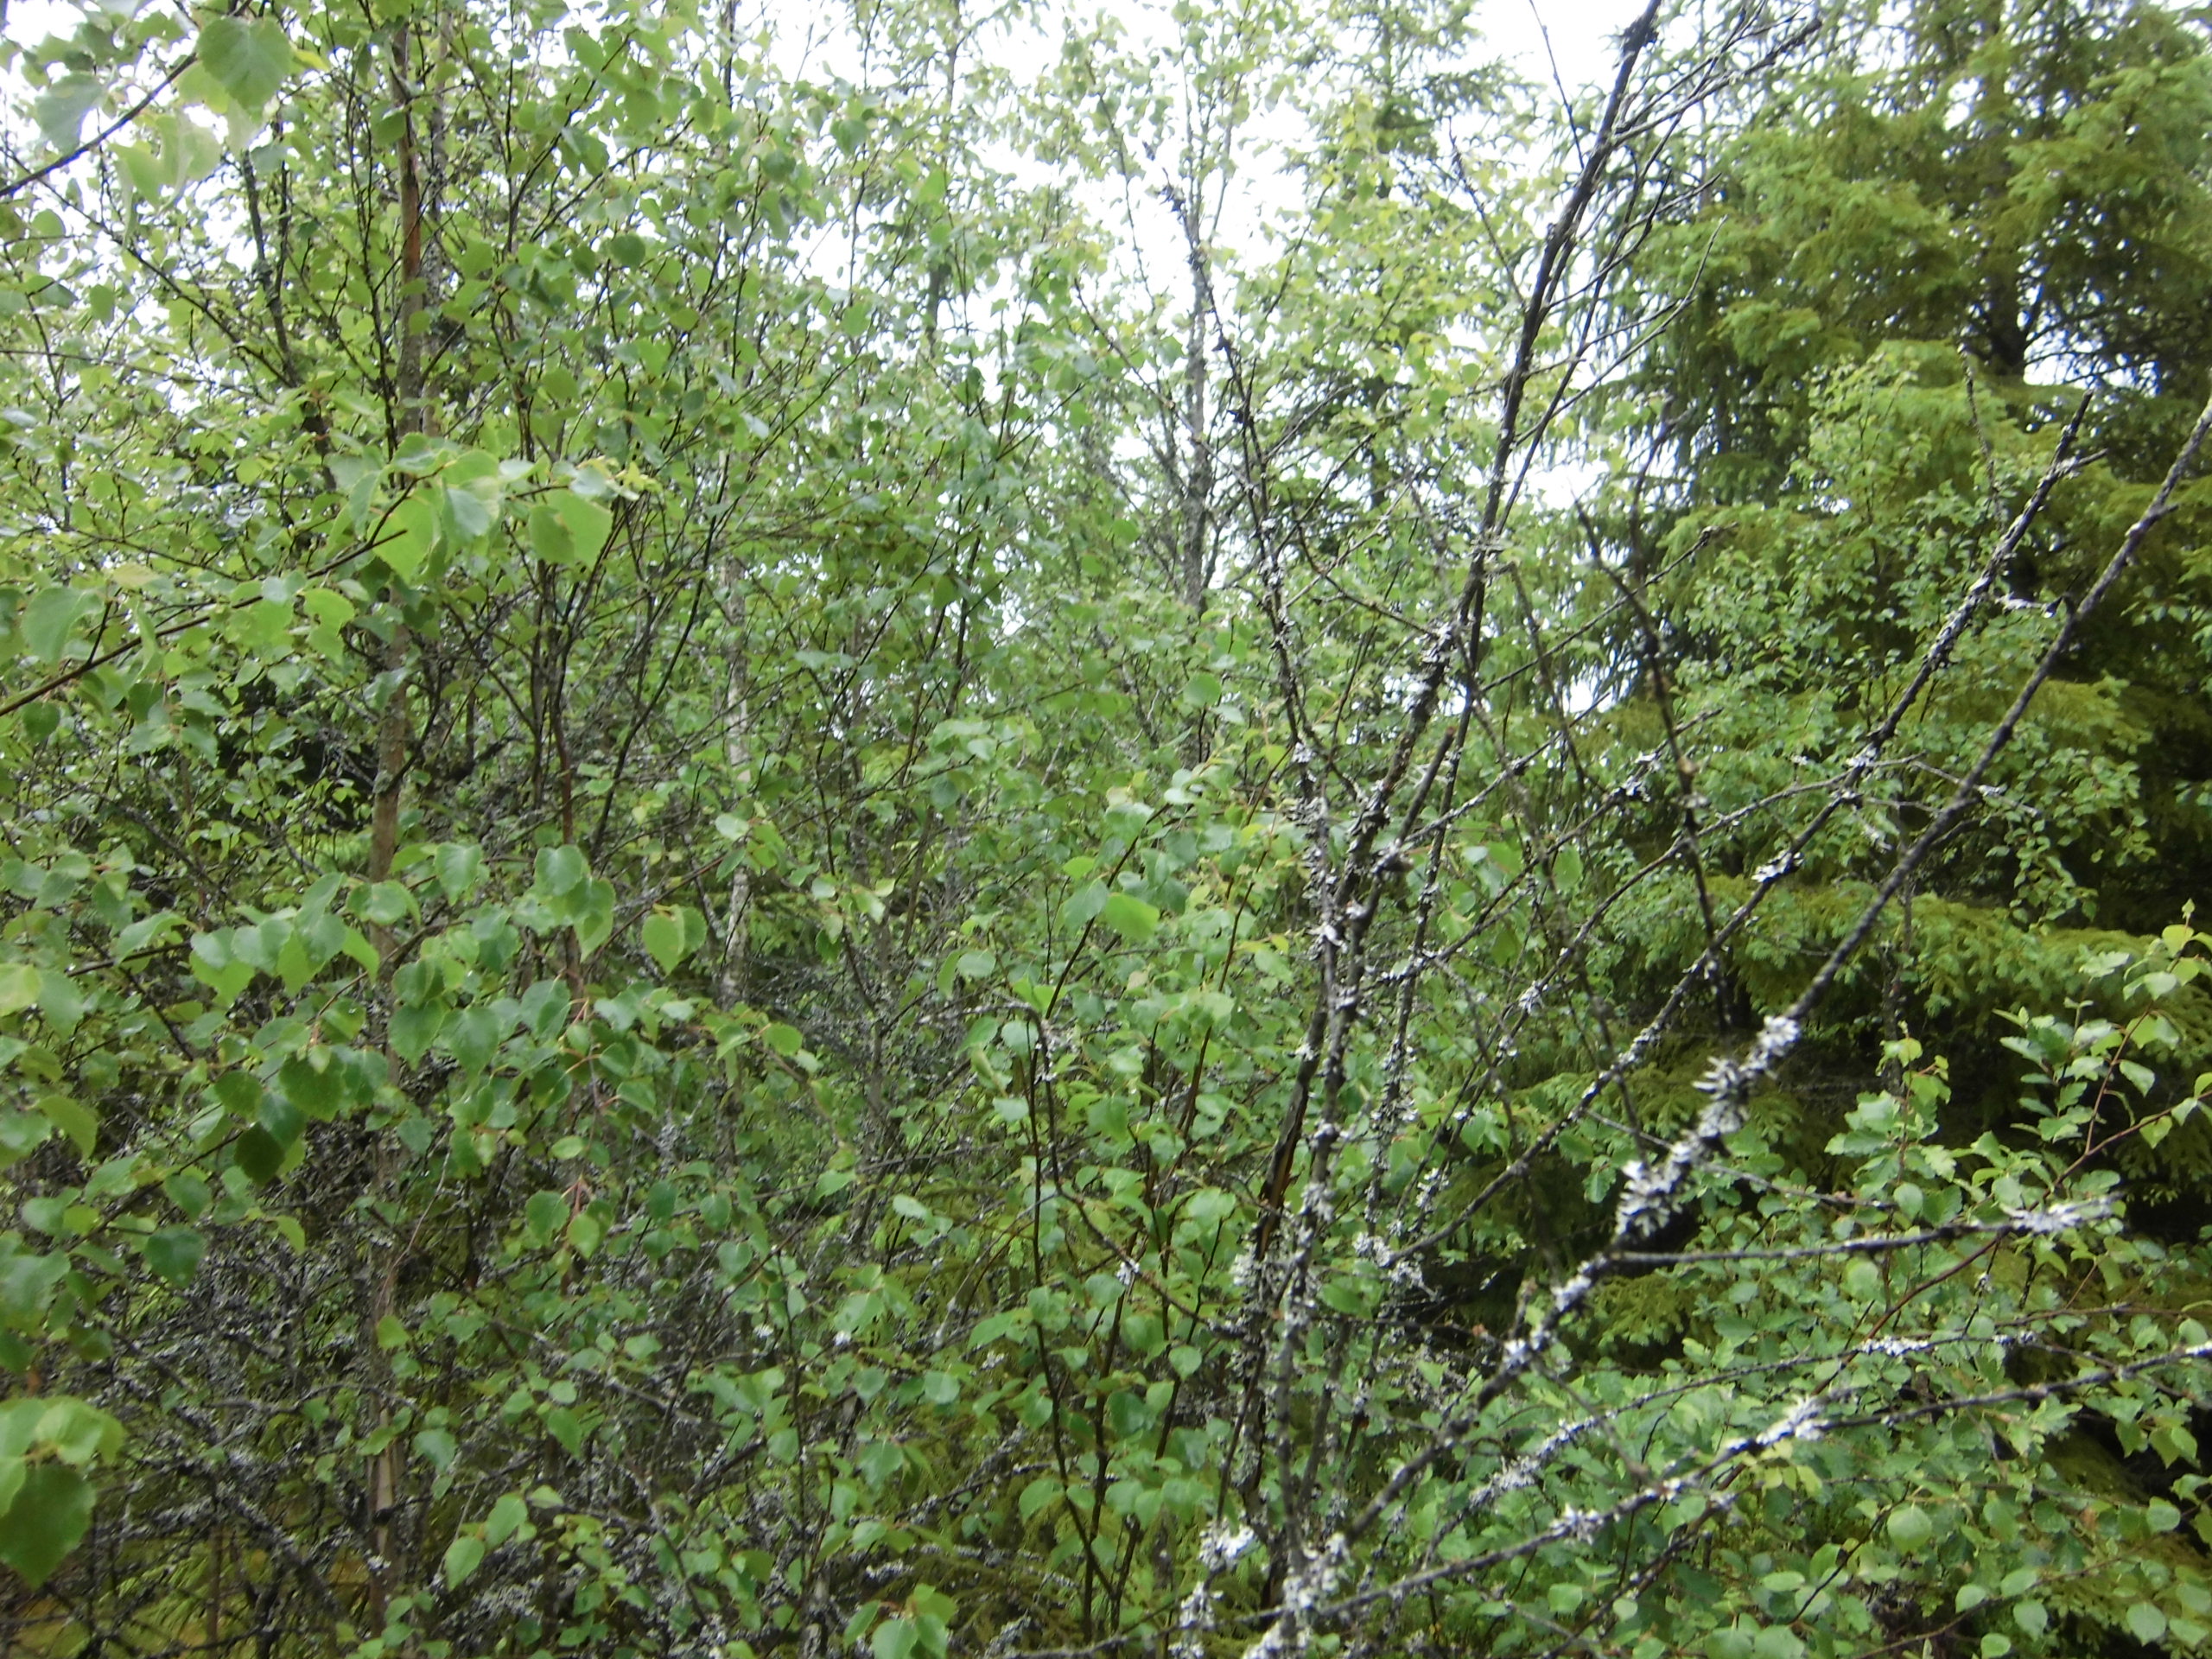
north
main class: Woodland
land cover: Spruce dominated mixed woodland
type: boreal forest
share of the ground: 50 - 75 %
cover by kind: coniferous forest trees 30 %, broadleaved forest trees 30 %, lichens and mosses 20 %, shrubs 10 %, herbaceous plants 10 %
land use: Forestry
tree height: > 5 m
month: June
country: SE
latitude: 57.0597
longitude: 15.0923
